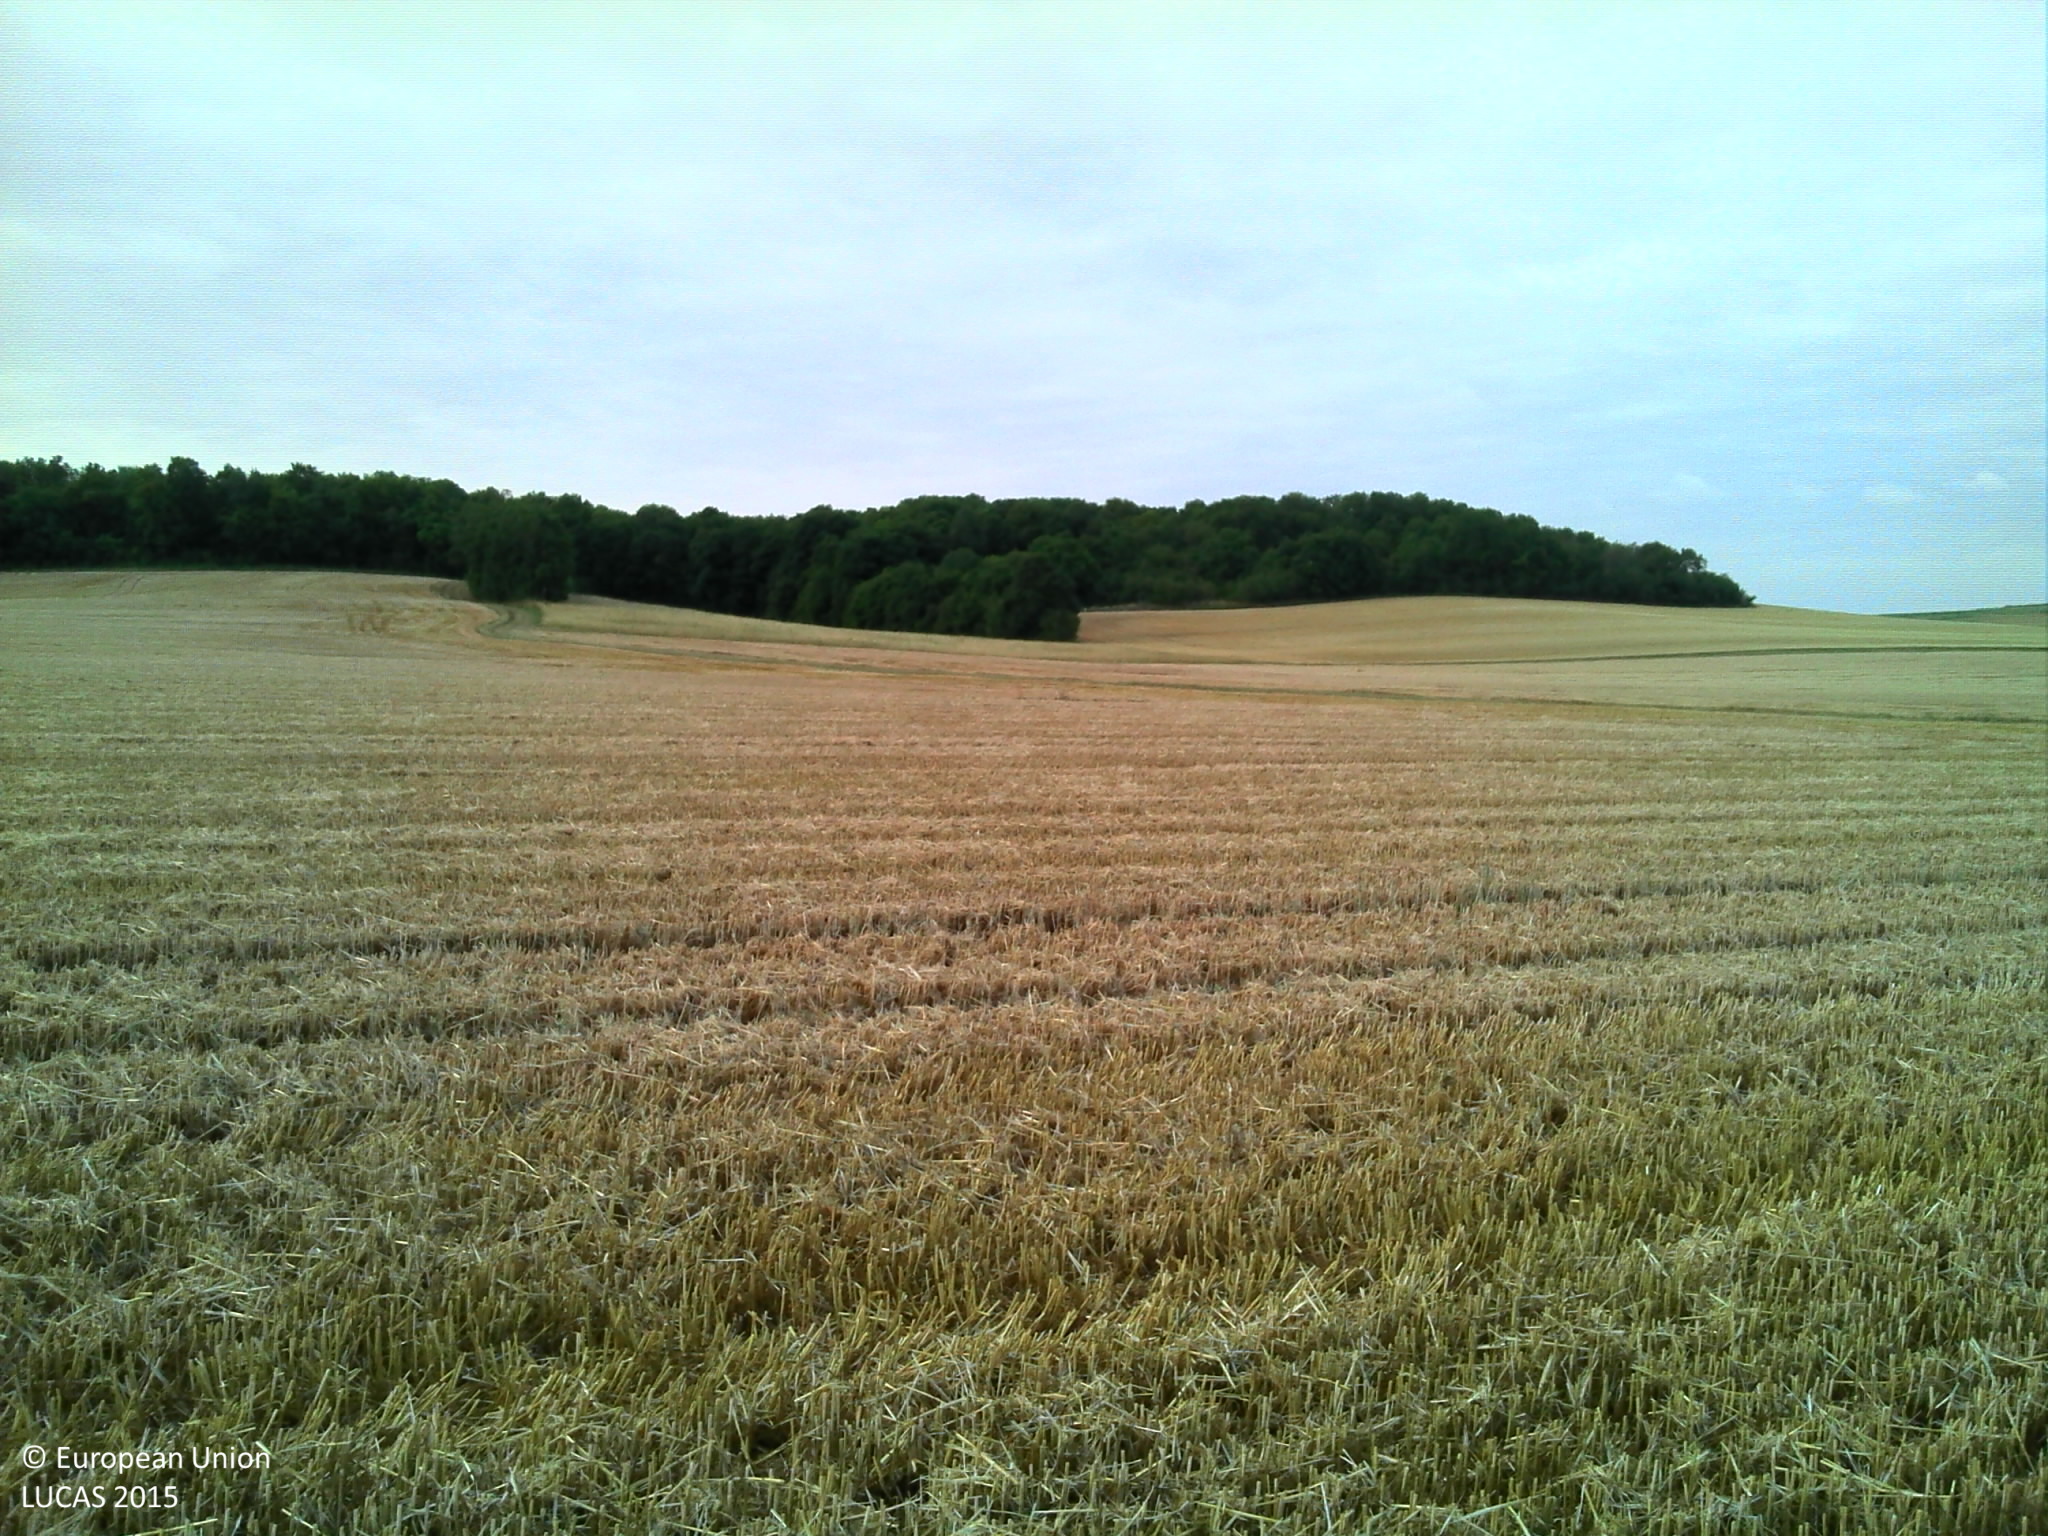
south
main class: Cropland
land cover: Common wheat
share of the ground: > 75 %
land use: Agriculture (excluding fallow land and kitchen gardens)
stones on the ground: < 10 %
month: July
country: FR
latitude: 49.2755
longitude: 4.1262
